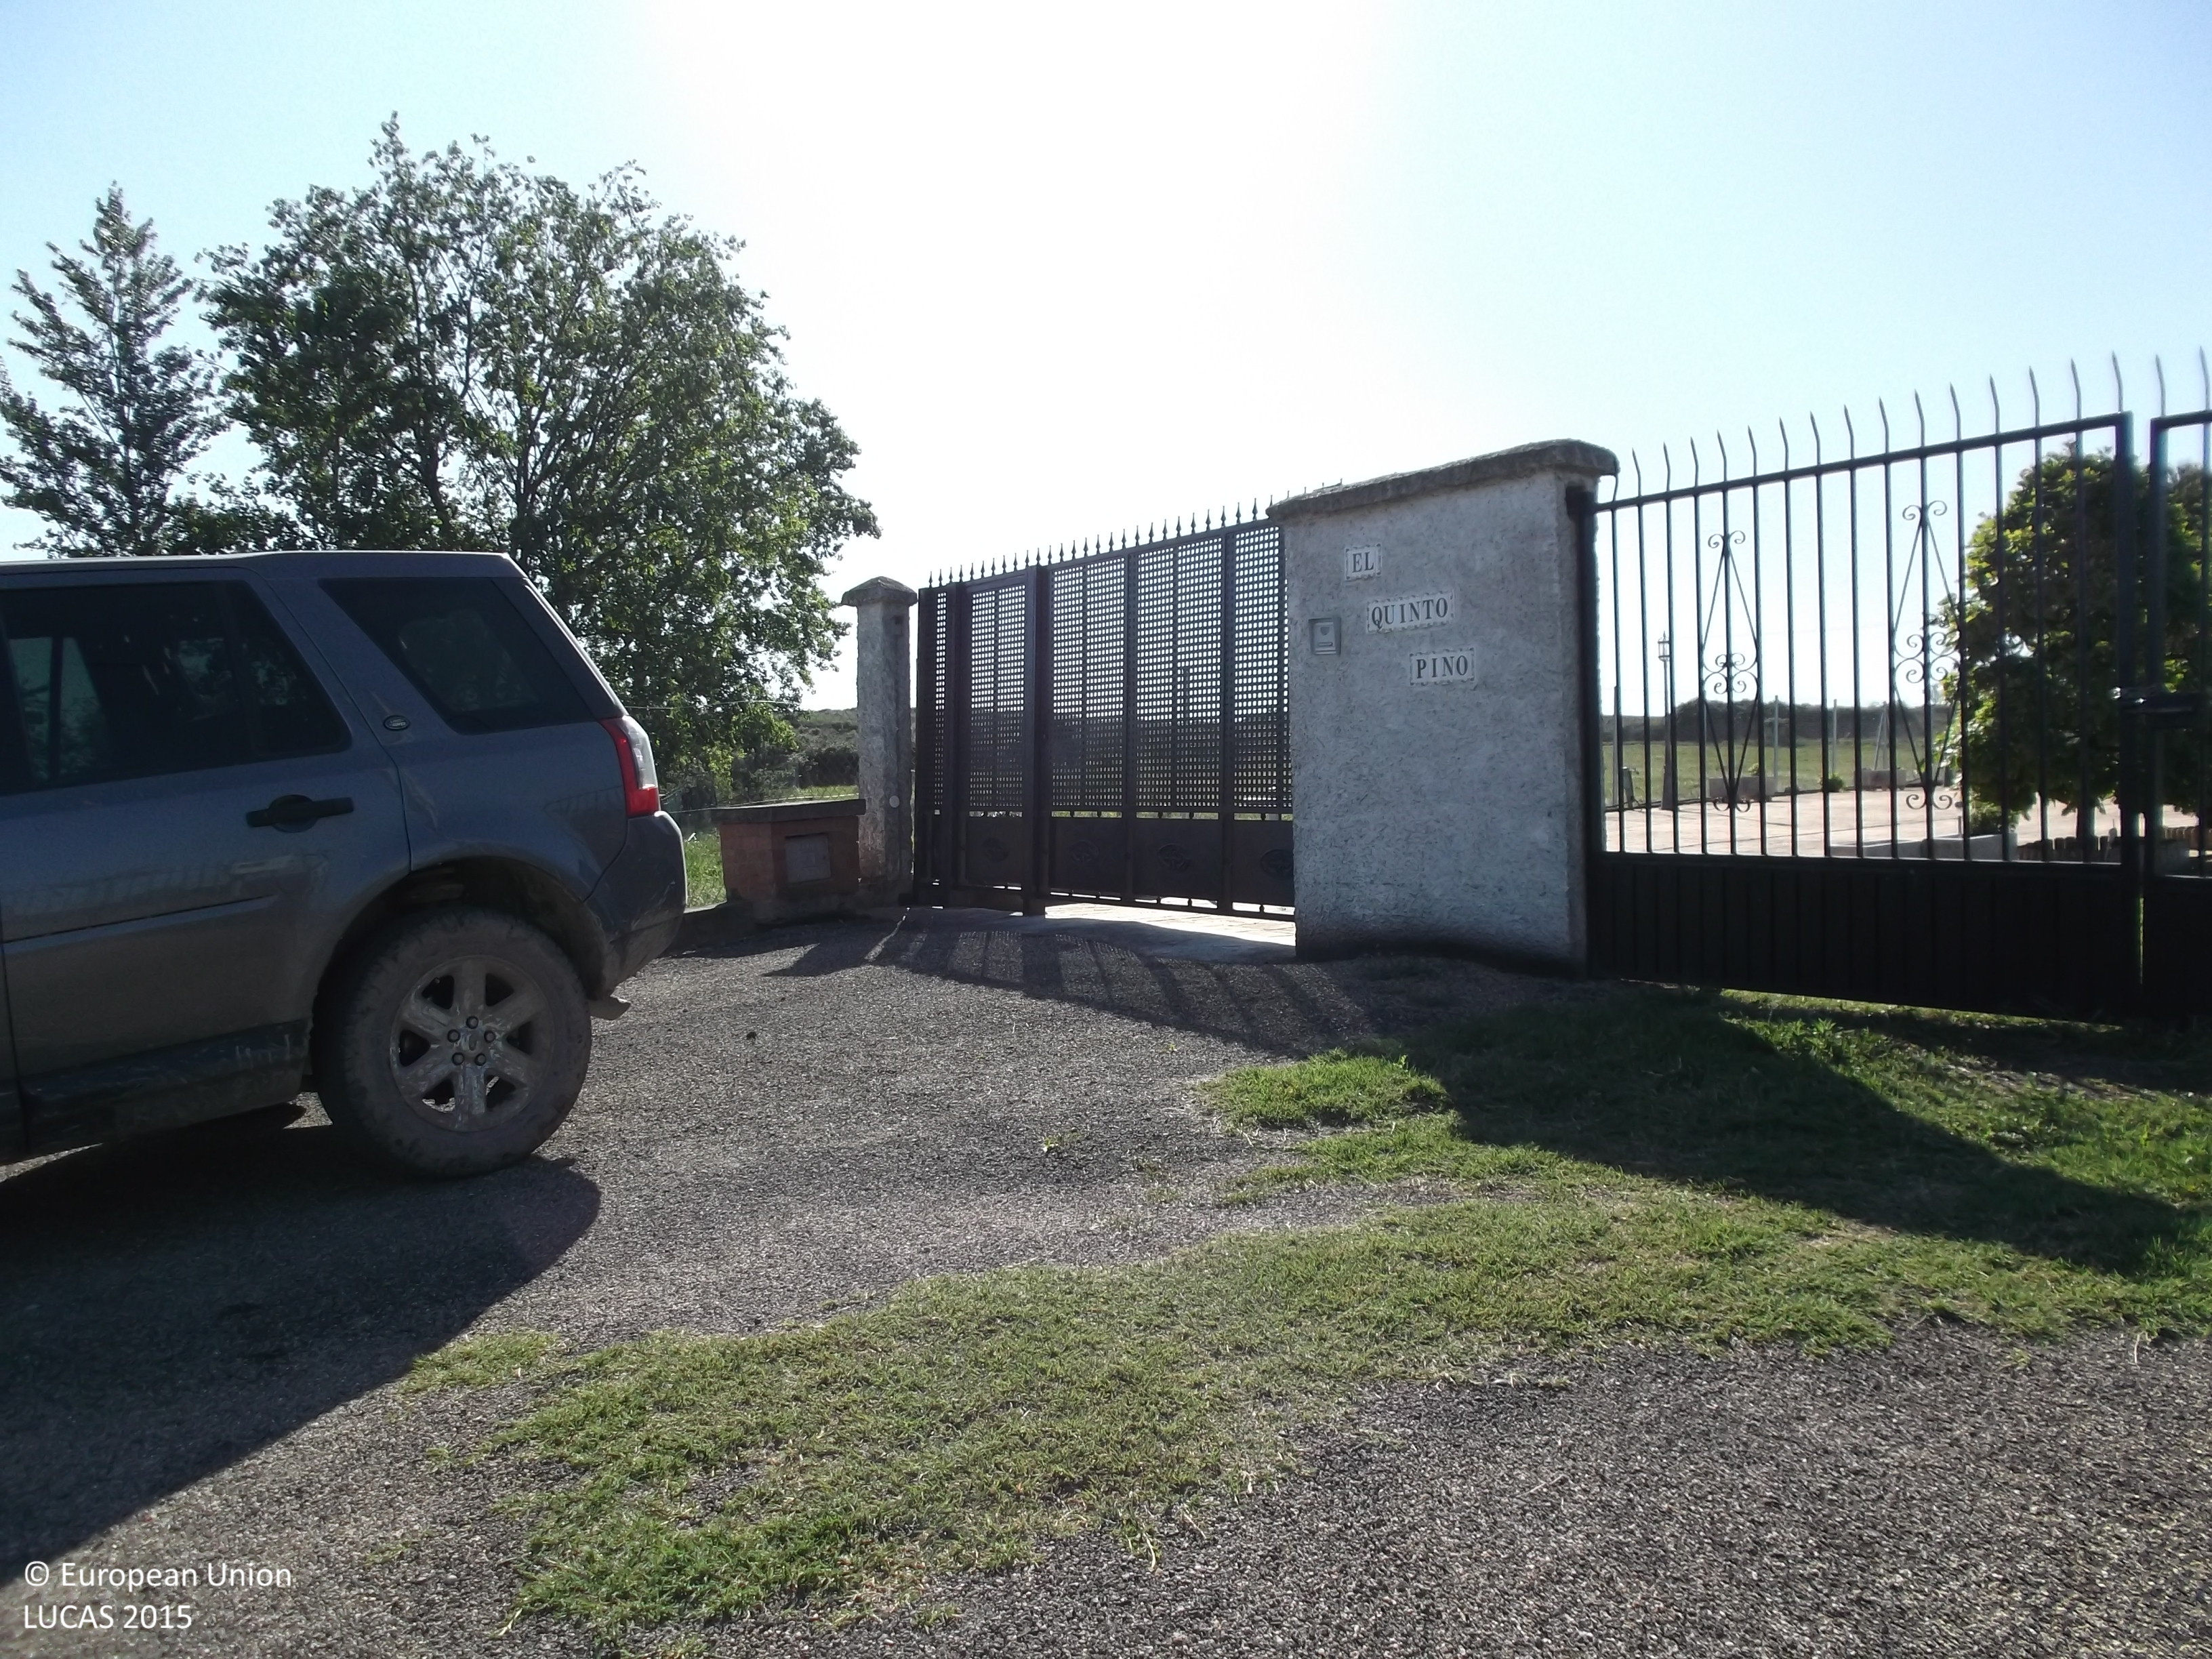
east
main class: Grassland
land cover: Grassland without tree/shrub cover
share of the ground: > 75 %
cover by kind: herbaceous plants 100 %
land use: Residential
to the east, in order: Grassland without tree/shrub cover; Artificial constructions in urban areas; Grassland without tree/shrub cover; Fences; Grass margins; Rivers and streams; Grassland without tree/shrub cover; Electric lines; Grassland without tree/shrub cover; Nuts trees; Grassland without tree/shrub cover; Rivers and streams; Grassland with sparse tree/shrub cover
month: May
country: ES
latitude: 42.4148
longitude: -2.4270
